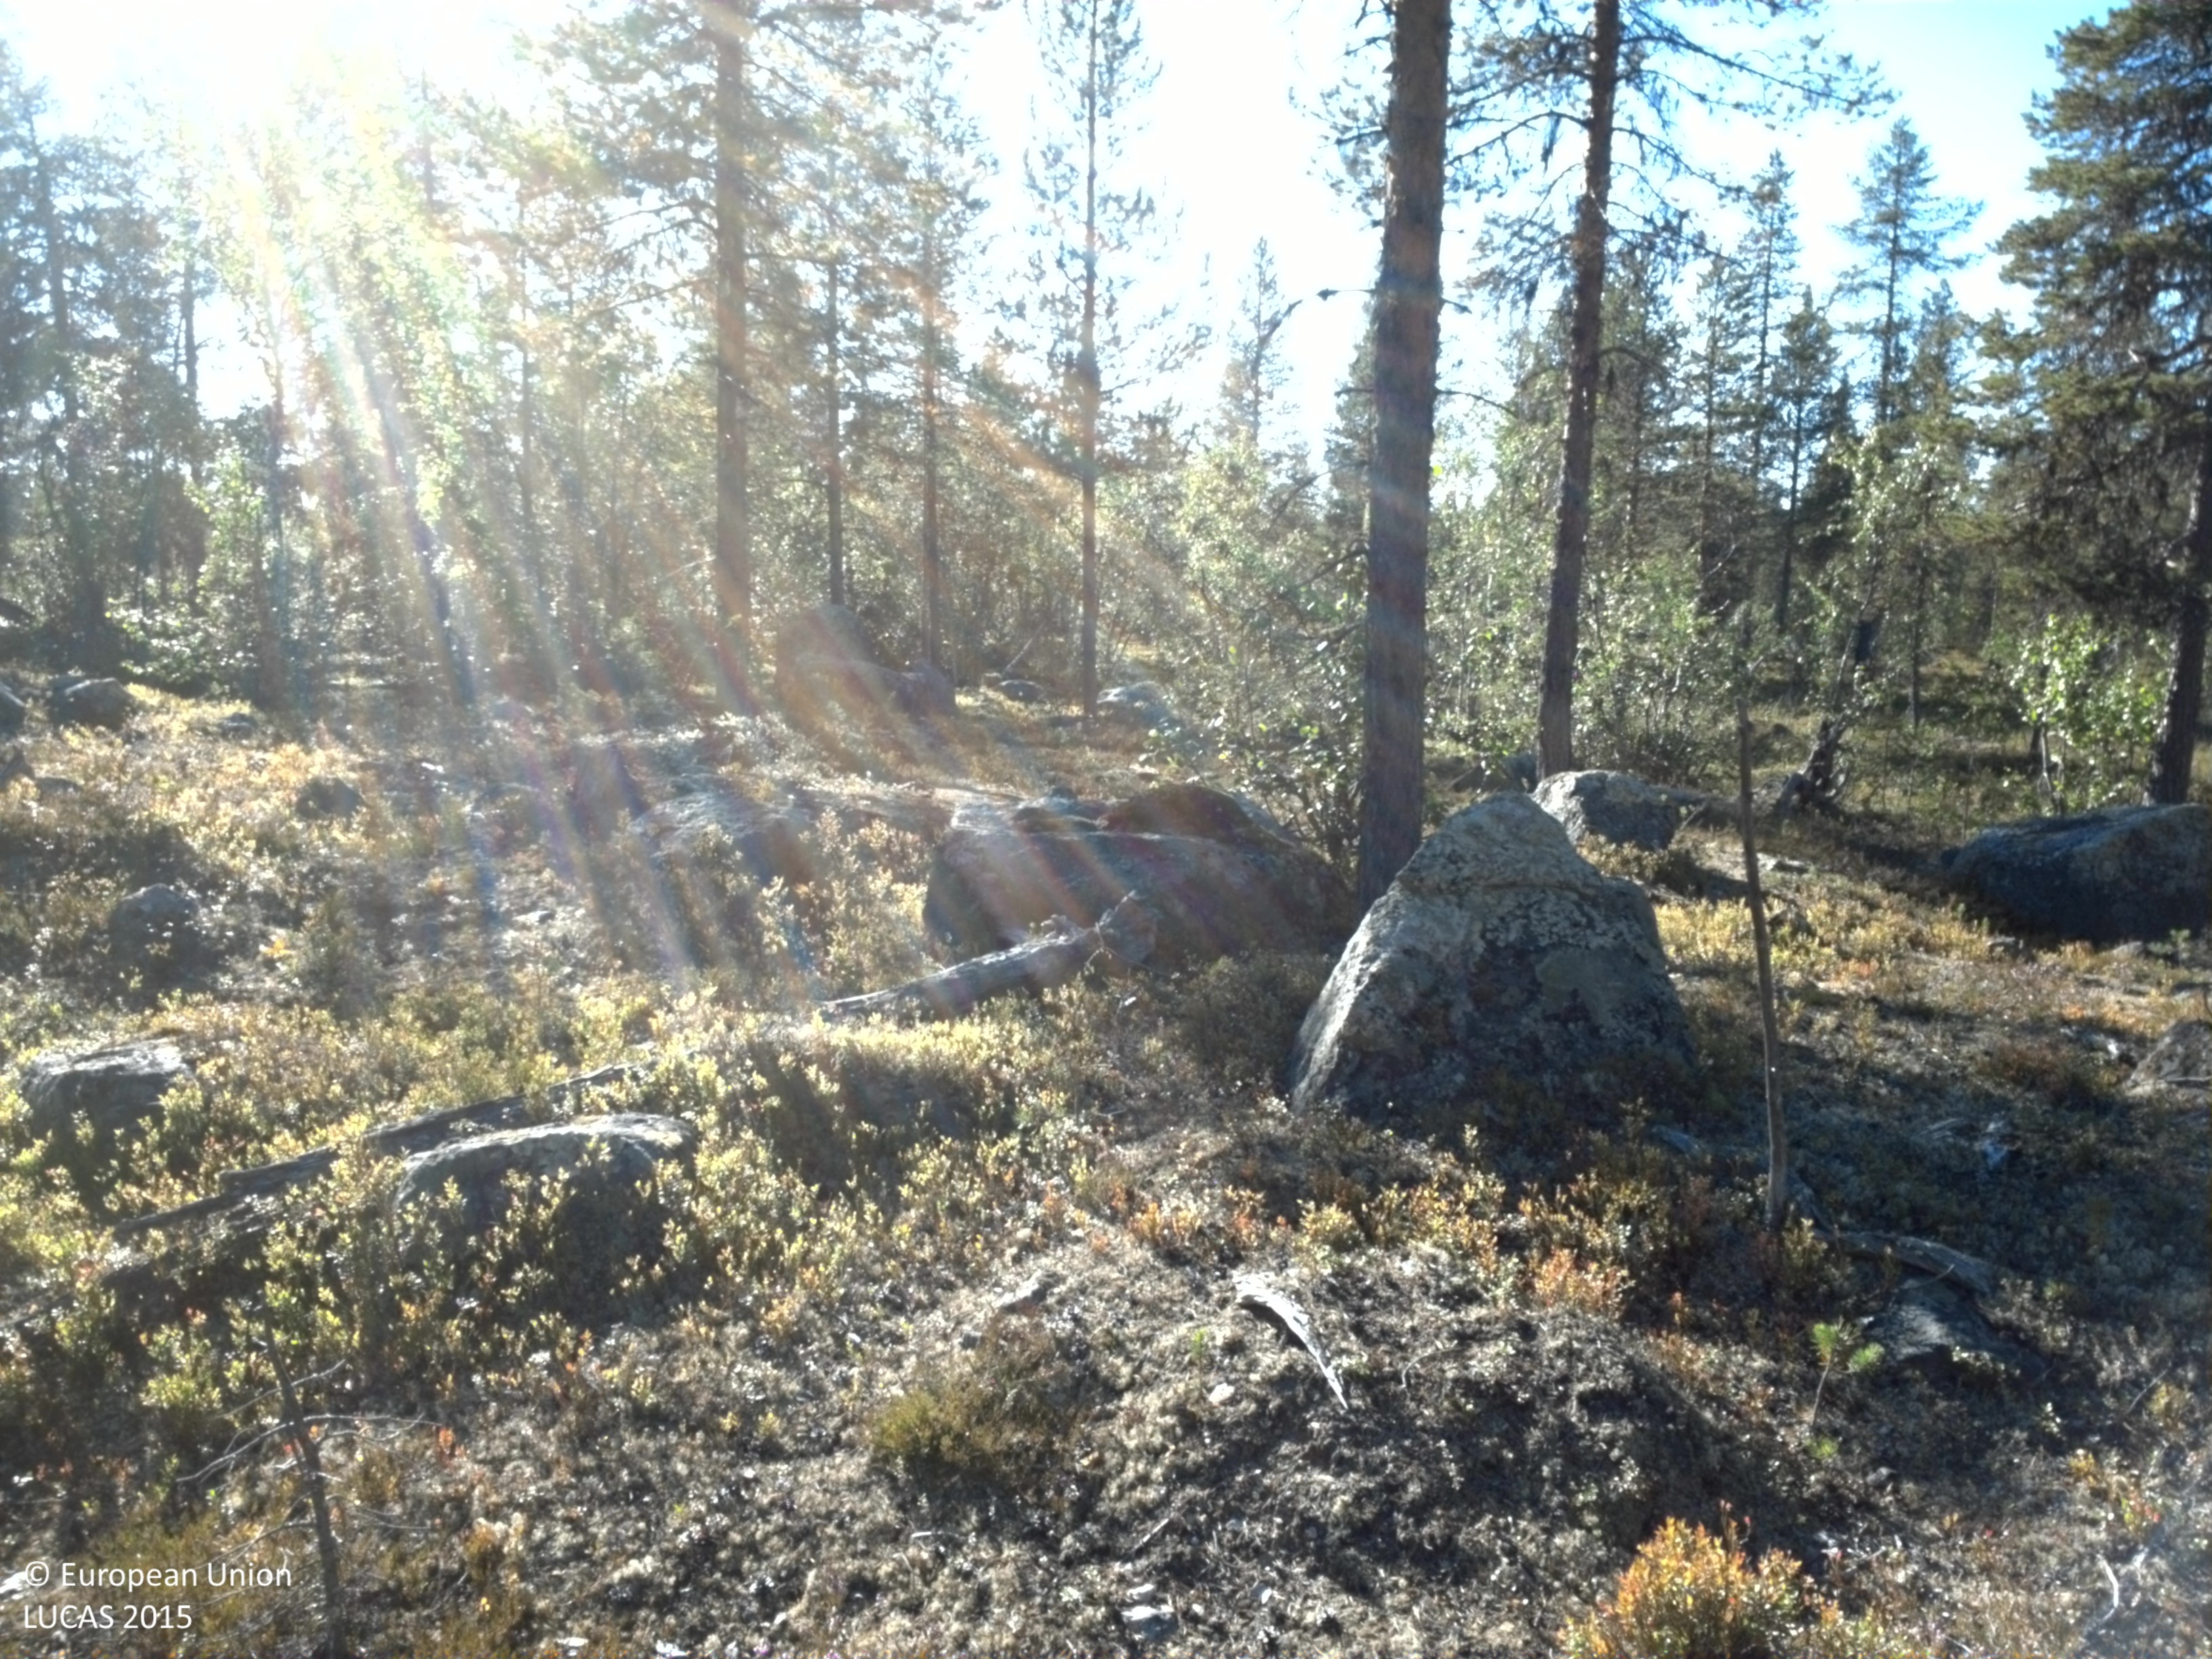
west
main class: Woodland
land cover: Pine dominated mixed woodland
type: boreal forest
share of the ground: 25 - 50 %
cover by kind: shrubs 50 %, coniferous forest trees 15 %, lichens and mosses 15 %, broadleaved forest trees 10 %, consolidated bare surface 10 %
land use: Forestry
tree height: > 5 m
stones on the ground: 25 - 50 %
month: August
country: SE
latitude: 66.6957
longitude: 18.9423
